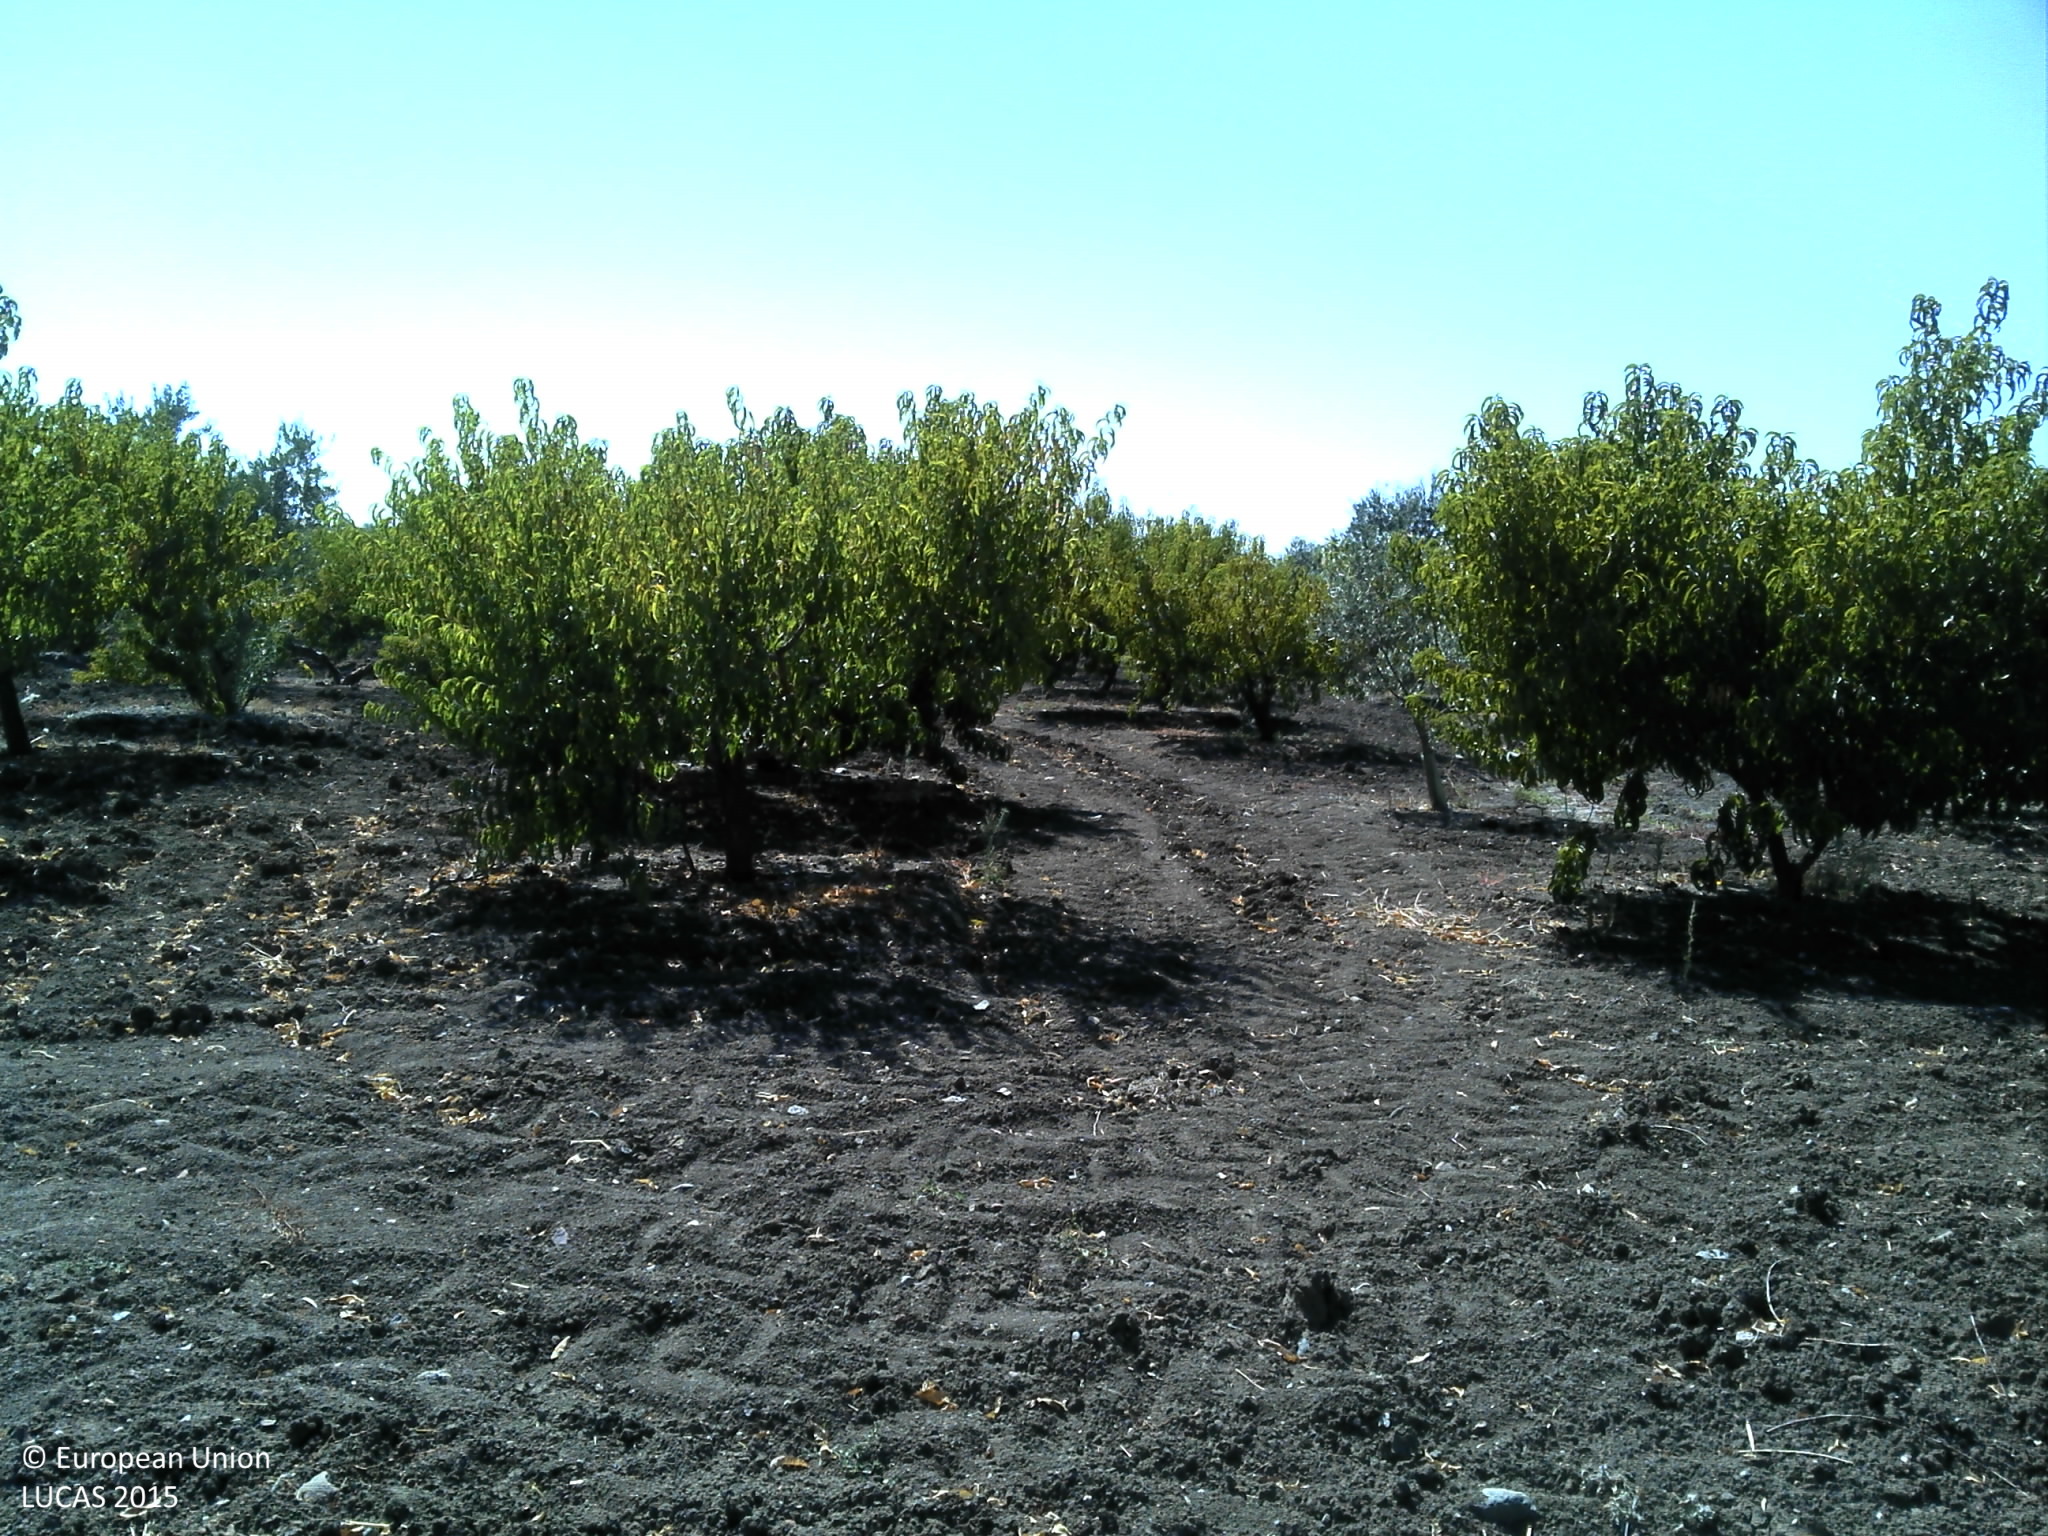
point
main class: Cropland
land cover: Other fruit trees and berries
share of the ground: 50 - 75 %
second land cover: Other bare soil
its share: > 75 %
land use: Agriculture (excluding fallow land and kitchen gardens)
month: August
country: PT
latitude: 38.0186
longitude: -7.8775
